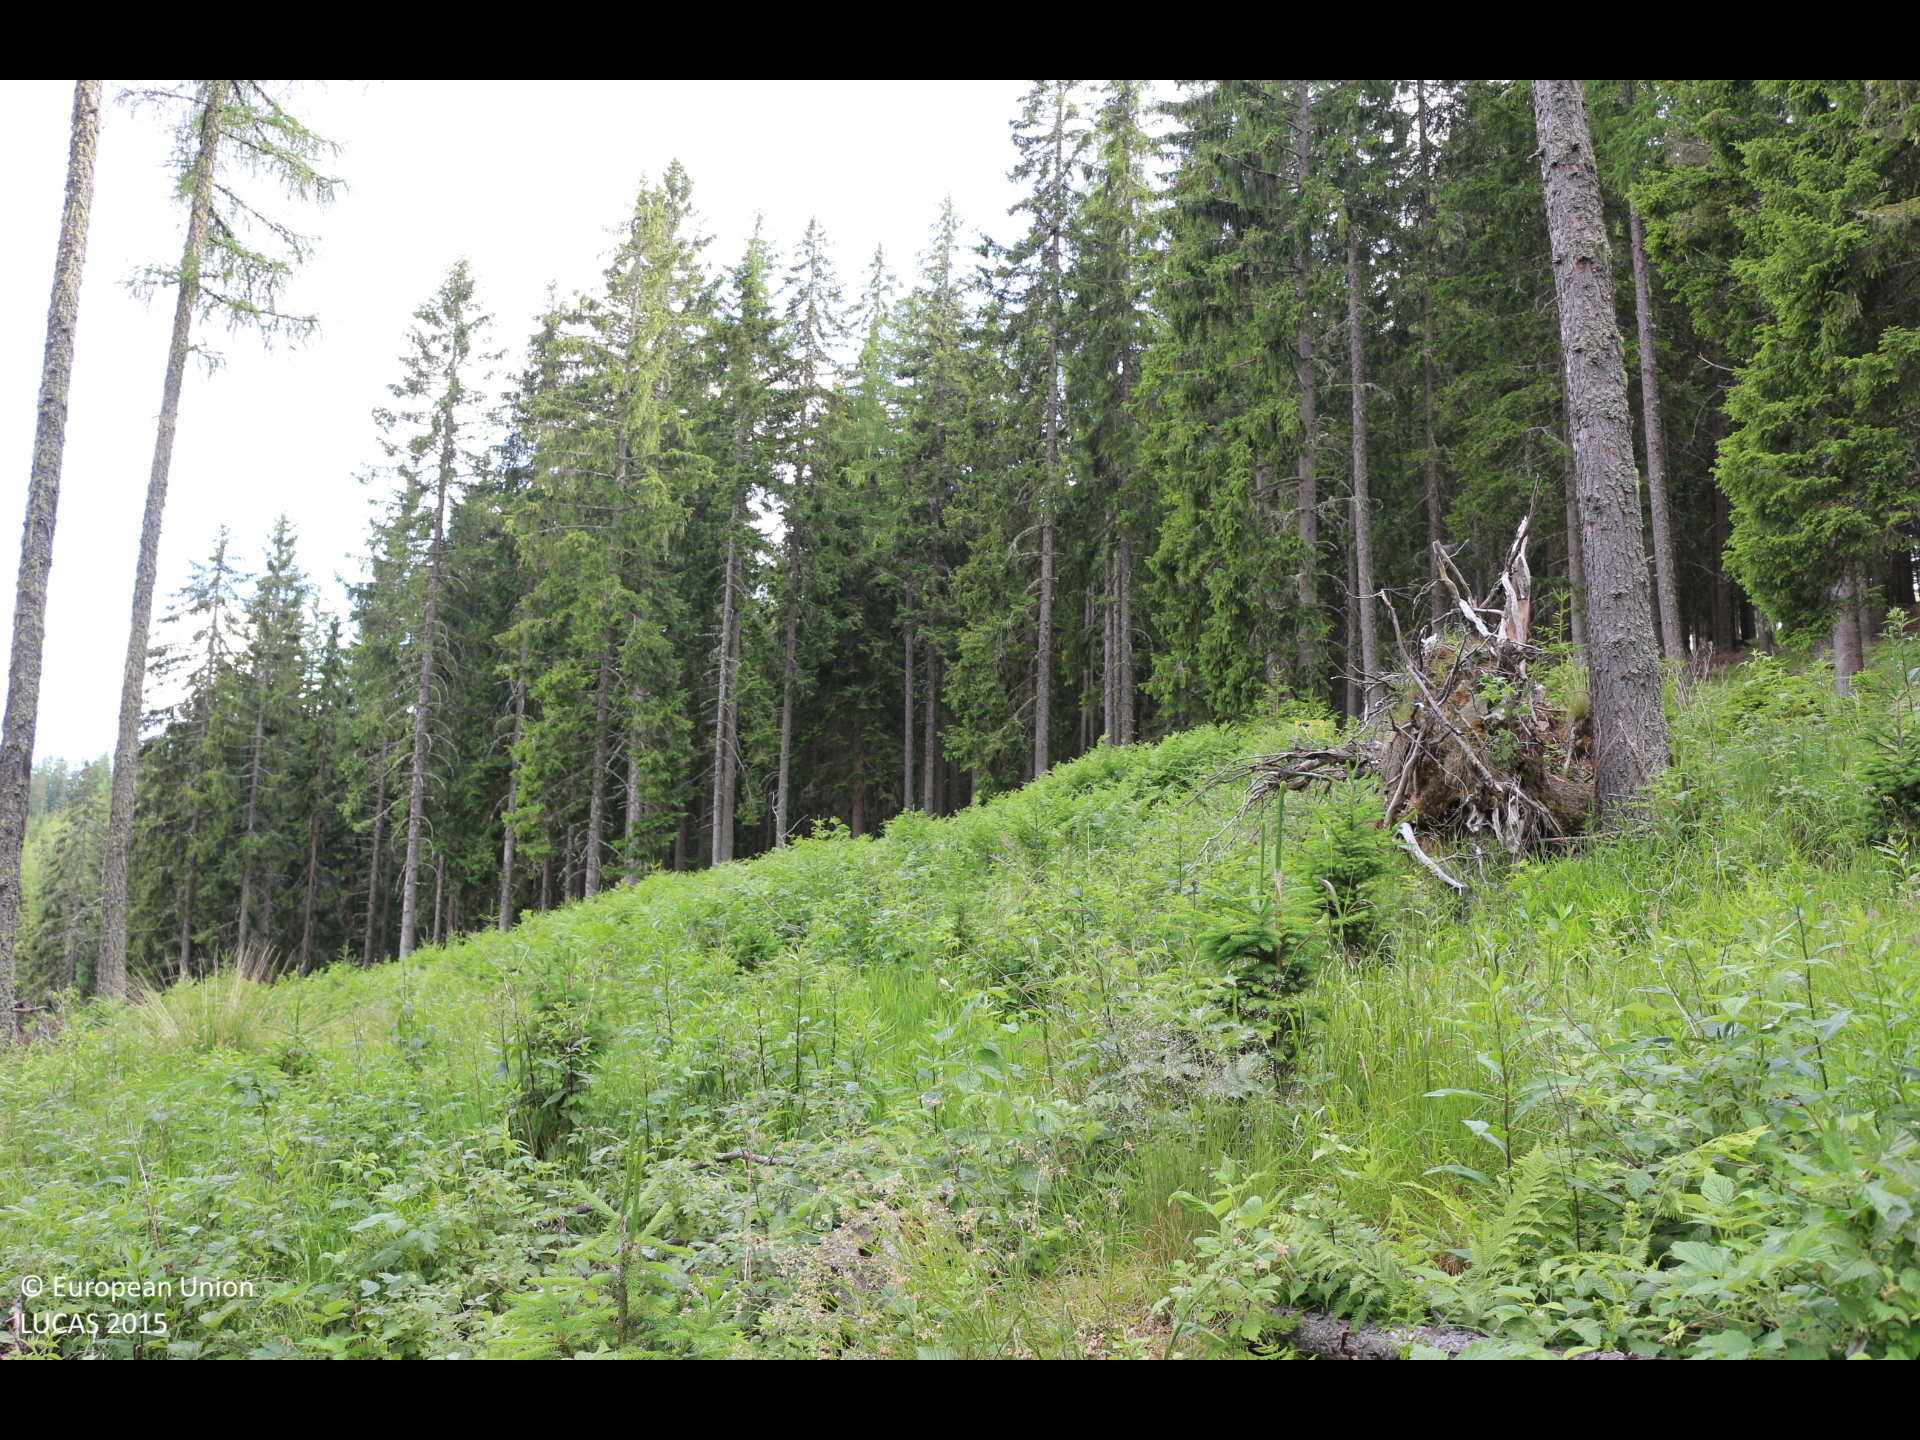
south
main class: Woodland
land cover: Other coniferous woodland
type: alpine coniferous forest
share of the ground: 25 - 50 %
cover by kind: herbaceous plants 60 %, coniferous forest trees 30 %, shrubs 10 %
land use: Forestry
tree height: > 5 m
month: June
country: AT
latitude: 46.9025
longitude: 14.1329
